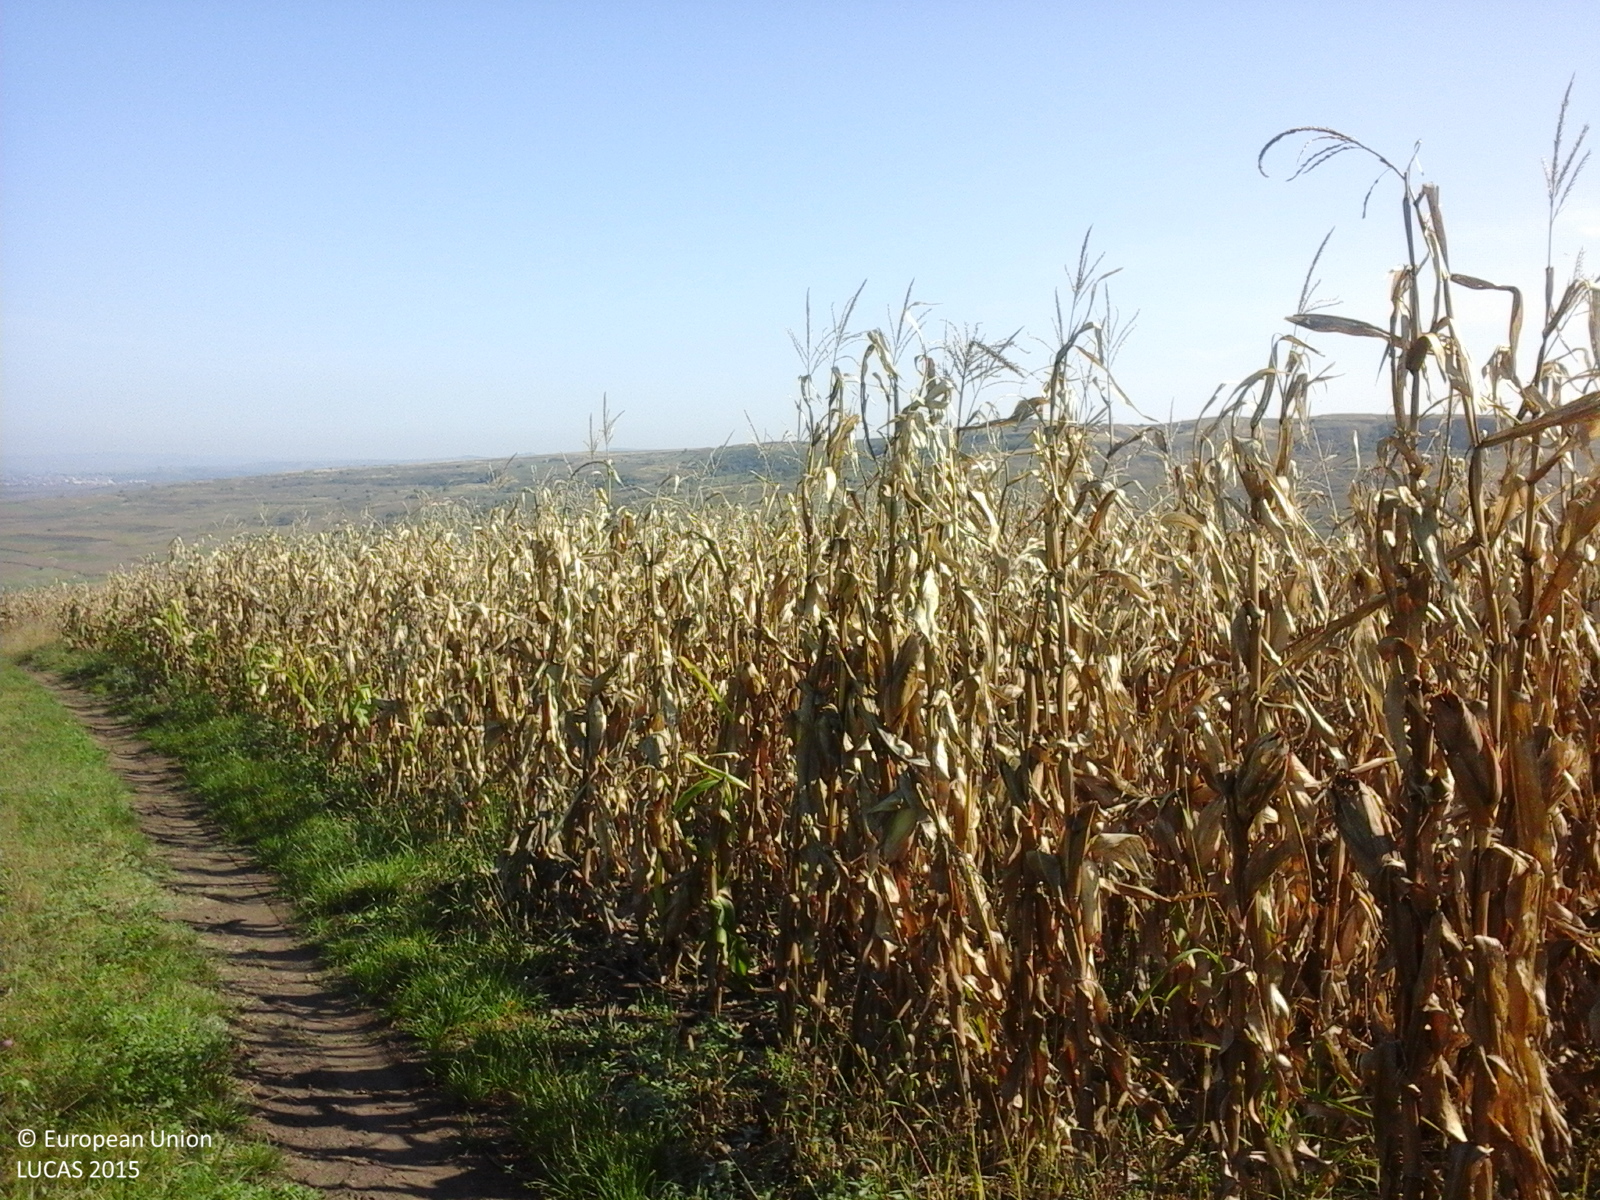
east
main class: Cropland
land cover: Maize
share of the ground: > 75 %
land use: Agriculture (excluding fallow land and kitchen gardens)
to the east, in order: Maize; Spontaneously vegetated surfaces; Maize; Spontaneously vegetated surfaces; Maize
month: October
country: RO
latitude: 46.1203
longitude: 23.8532
